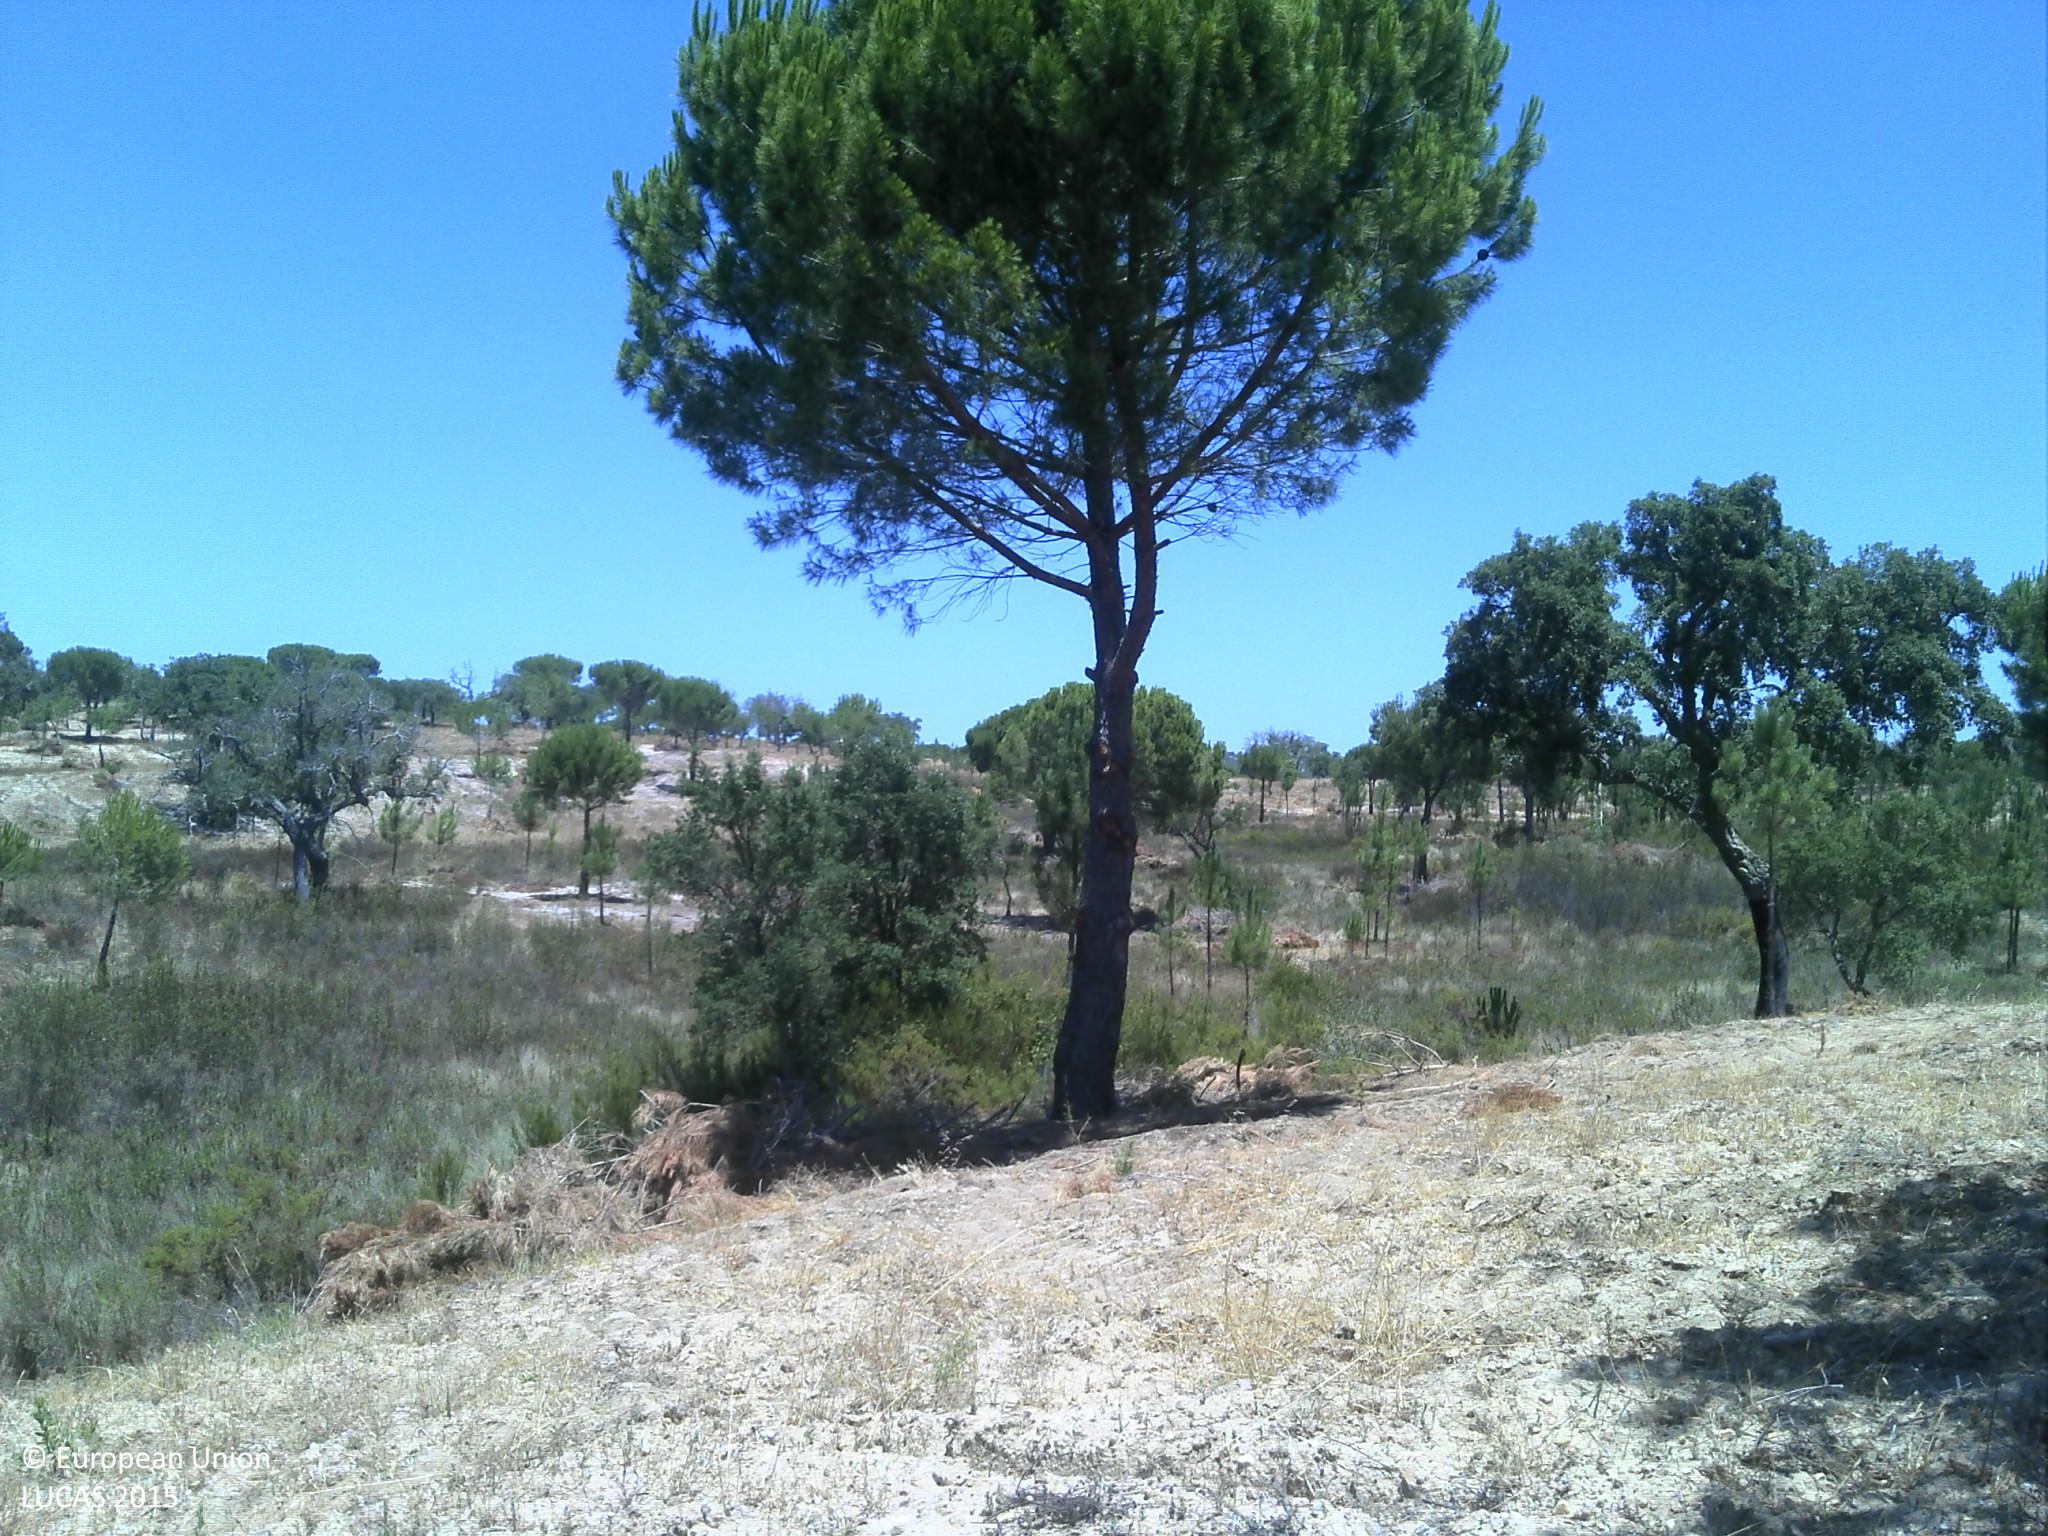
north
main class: Woodland
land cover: Broadleaved woodland
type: broadleaved evergreen forest
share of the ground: 25 - 50 %
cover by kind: unconsolidated bare surface 55 %, broadleaved forest trees 35 %, herbaceous plants 10 %
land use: Forestry
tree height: > 5 m
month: July
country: PT
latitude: 39.0511
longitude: -8.2803
